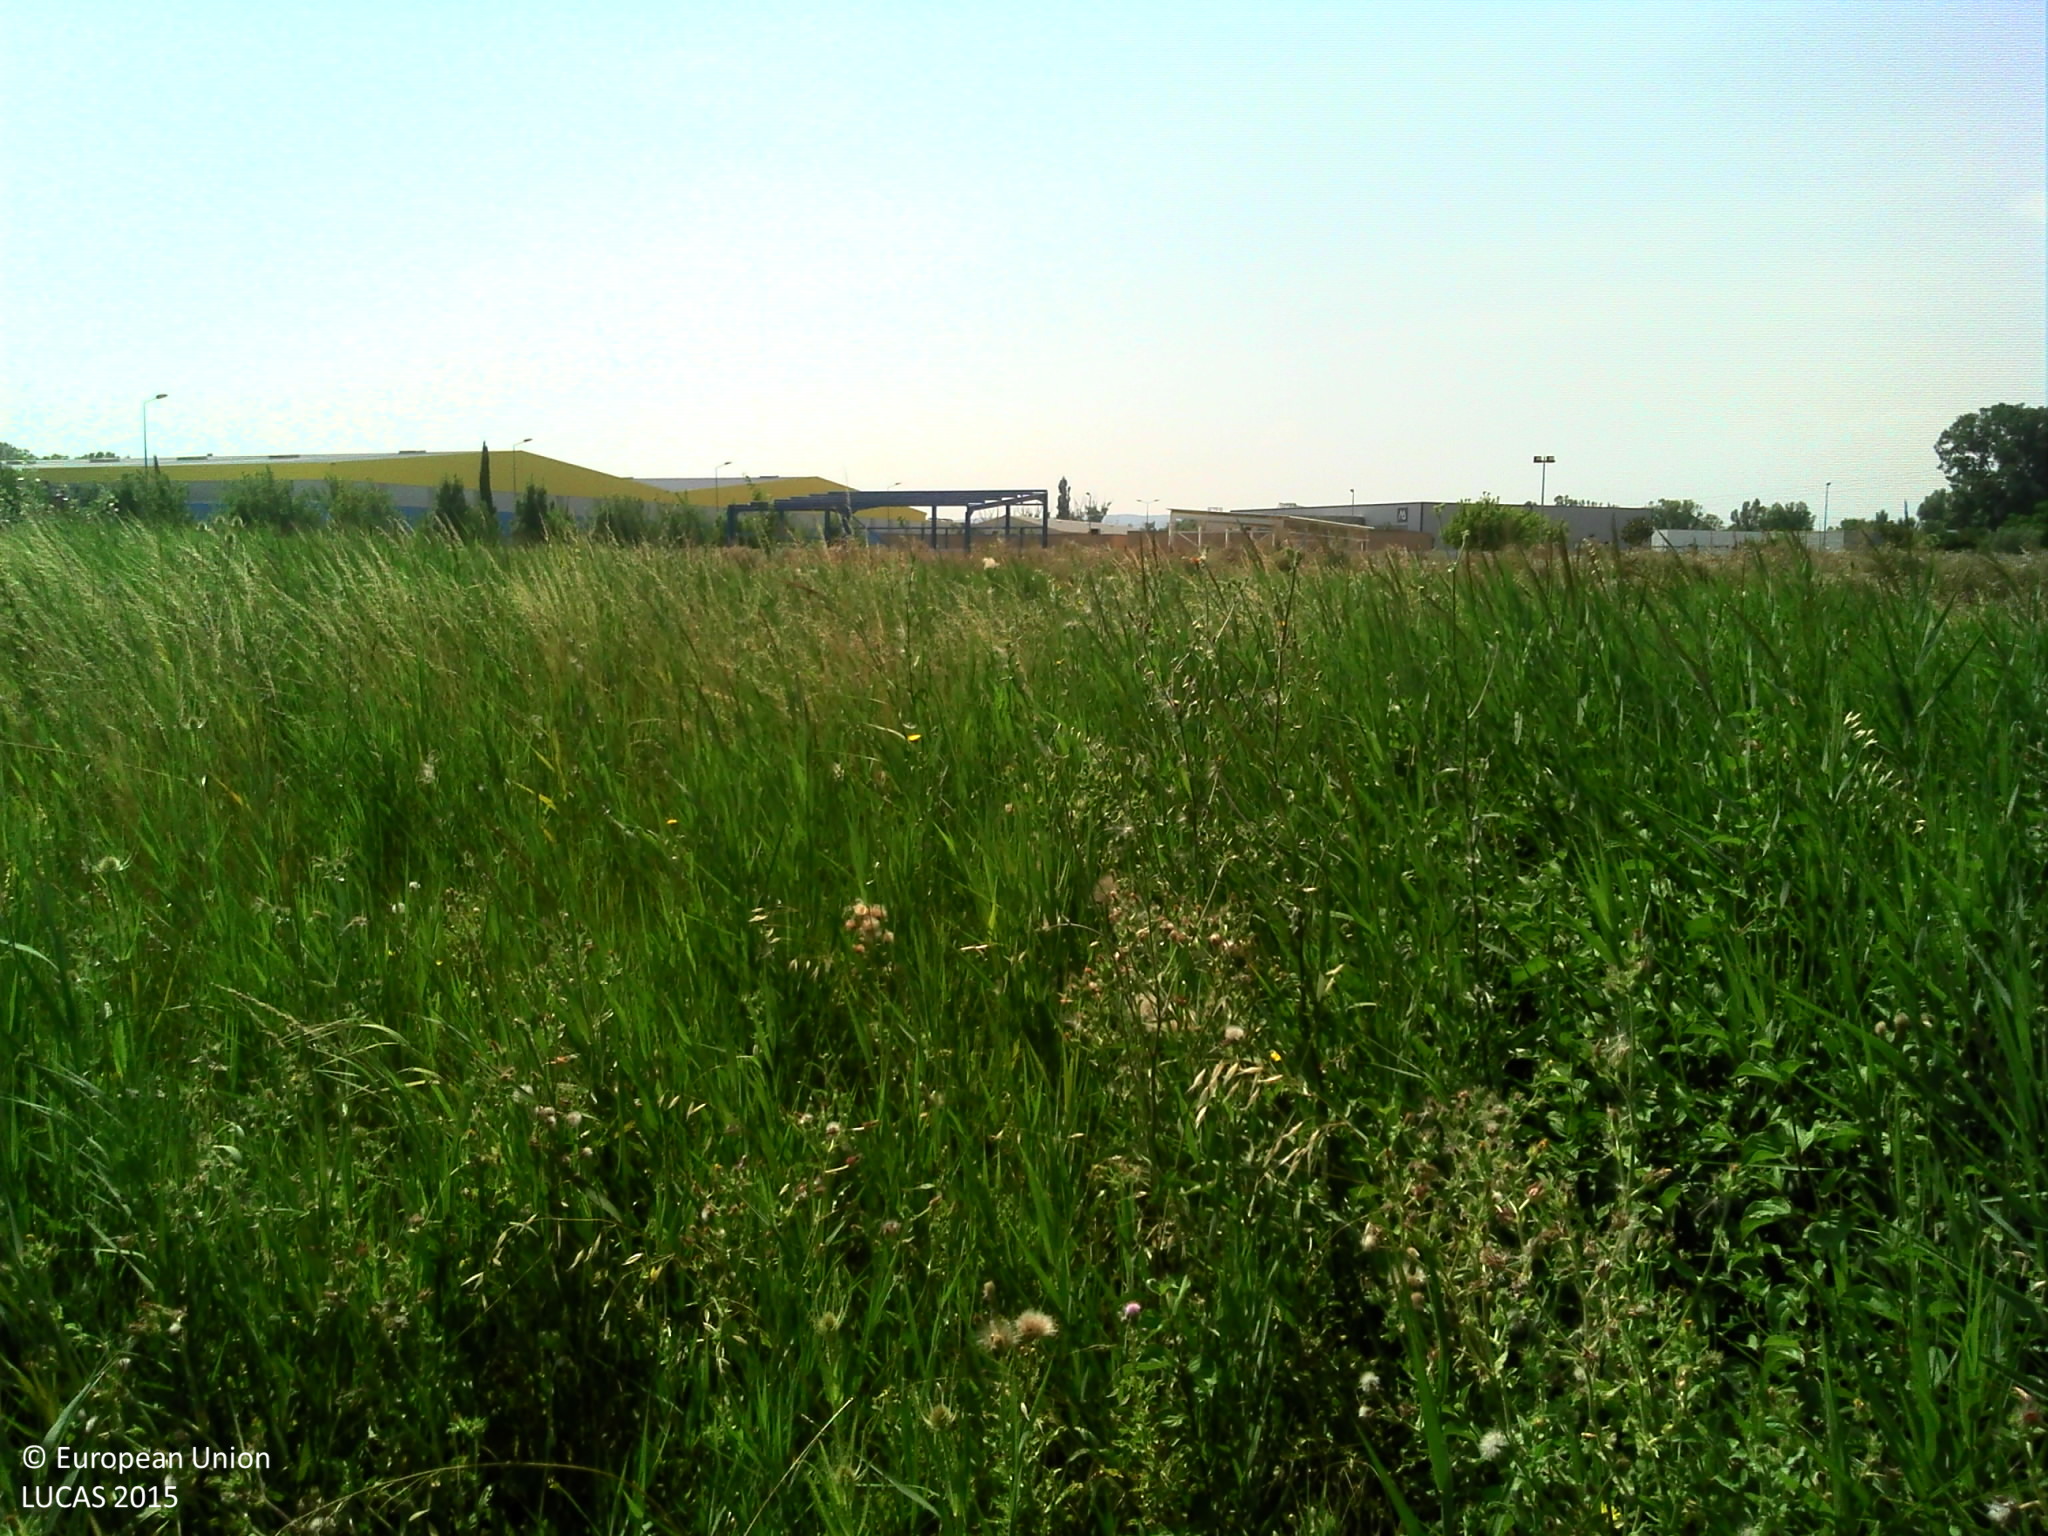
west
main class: Grassland
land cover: Spontaneously vegetated surfaces
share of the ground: > 75 %
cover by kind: herbaceous plants 100 %
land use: Semi-natural and natural areas not in use
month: July
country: FR
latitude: 44.3610
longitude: 4.7249
